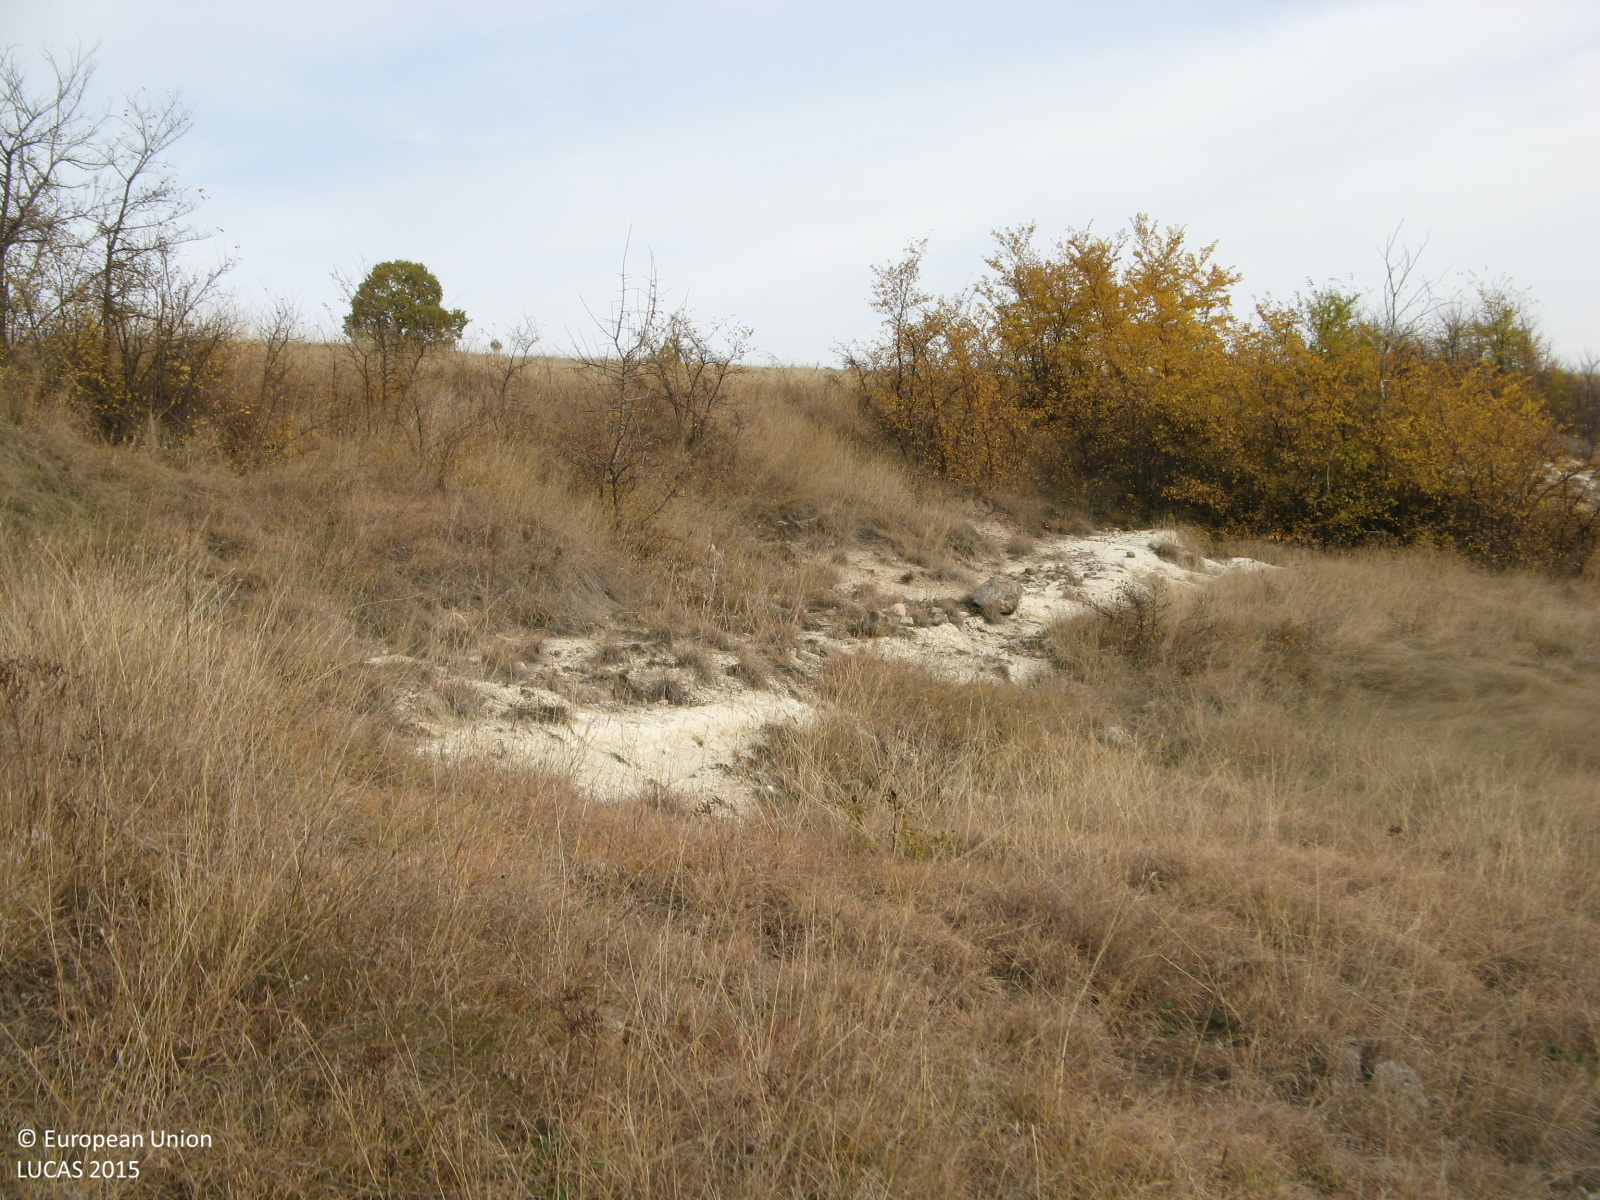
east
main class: Grassland
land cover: Grassland without tree/shrub cover
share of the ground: > 75 %
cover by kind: herbaceous plants 95 %, unconsolidated bare surface 5 %
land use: Semi-natural and natural areas not in use
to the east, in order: Grassland without tree/shrub cover; Rocks and stones; Grassland with sparse tree/shrub cover; Grassland without tree/shrub cover; Grassland with sparse tree/shrub cover; Grassland without tree/shrub cover; Rocks and stones
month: November
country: BG
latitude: 41.9864
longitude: 25.1323
